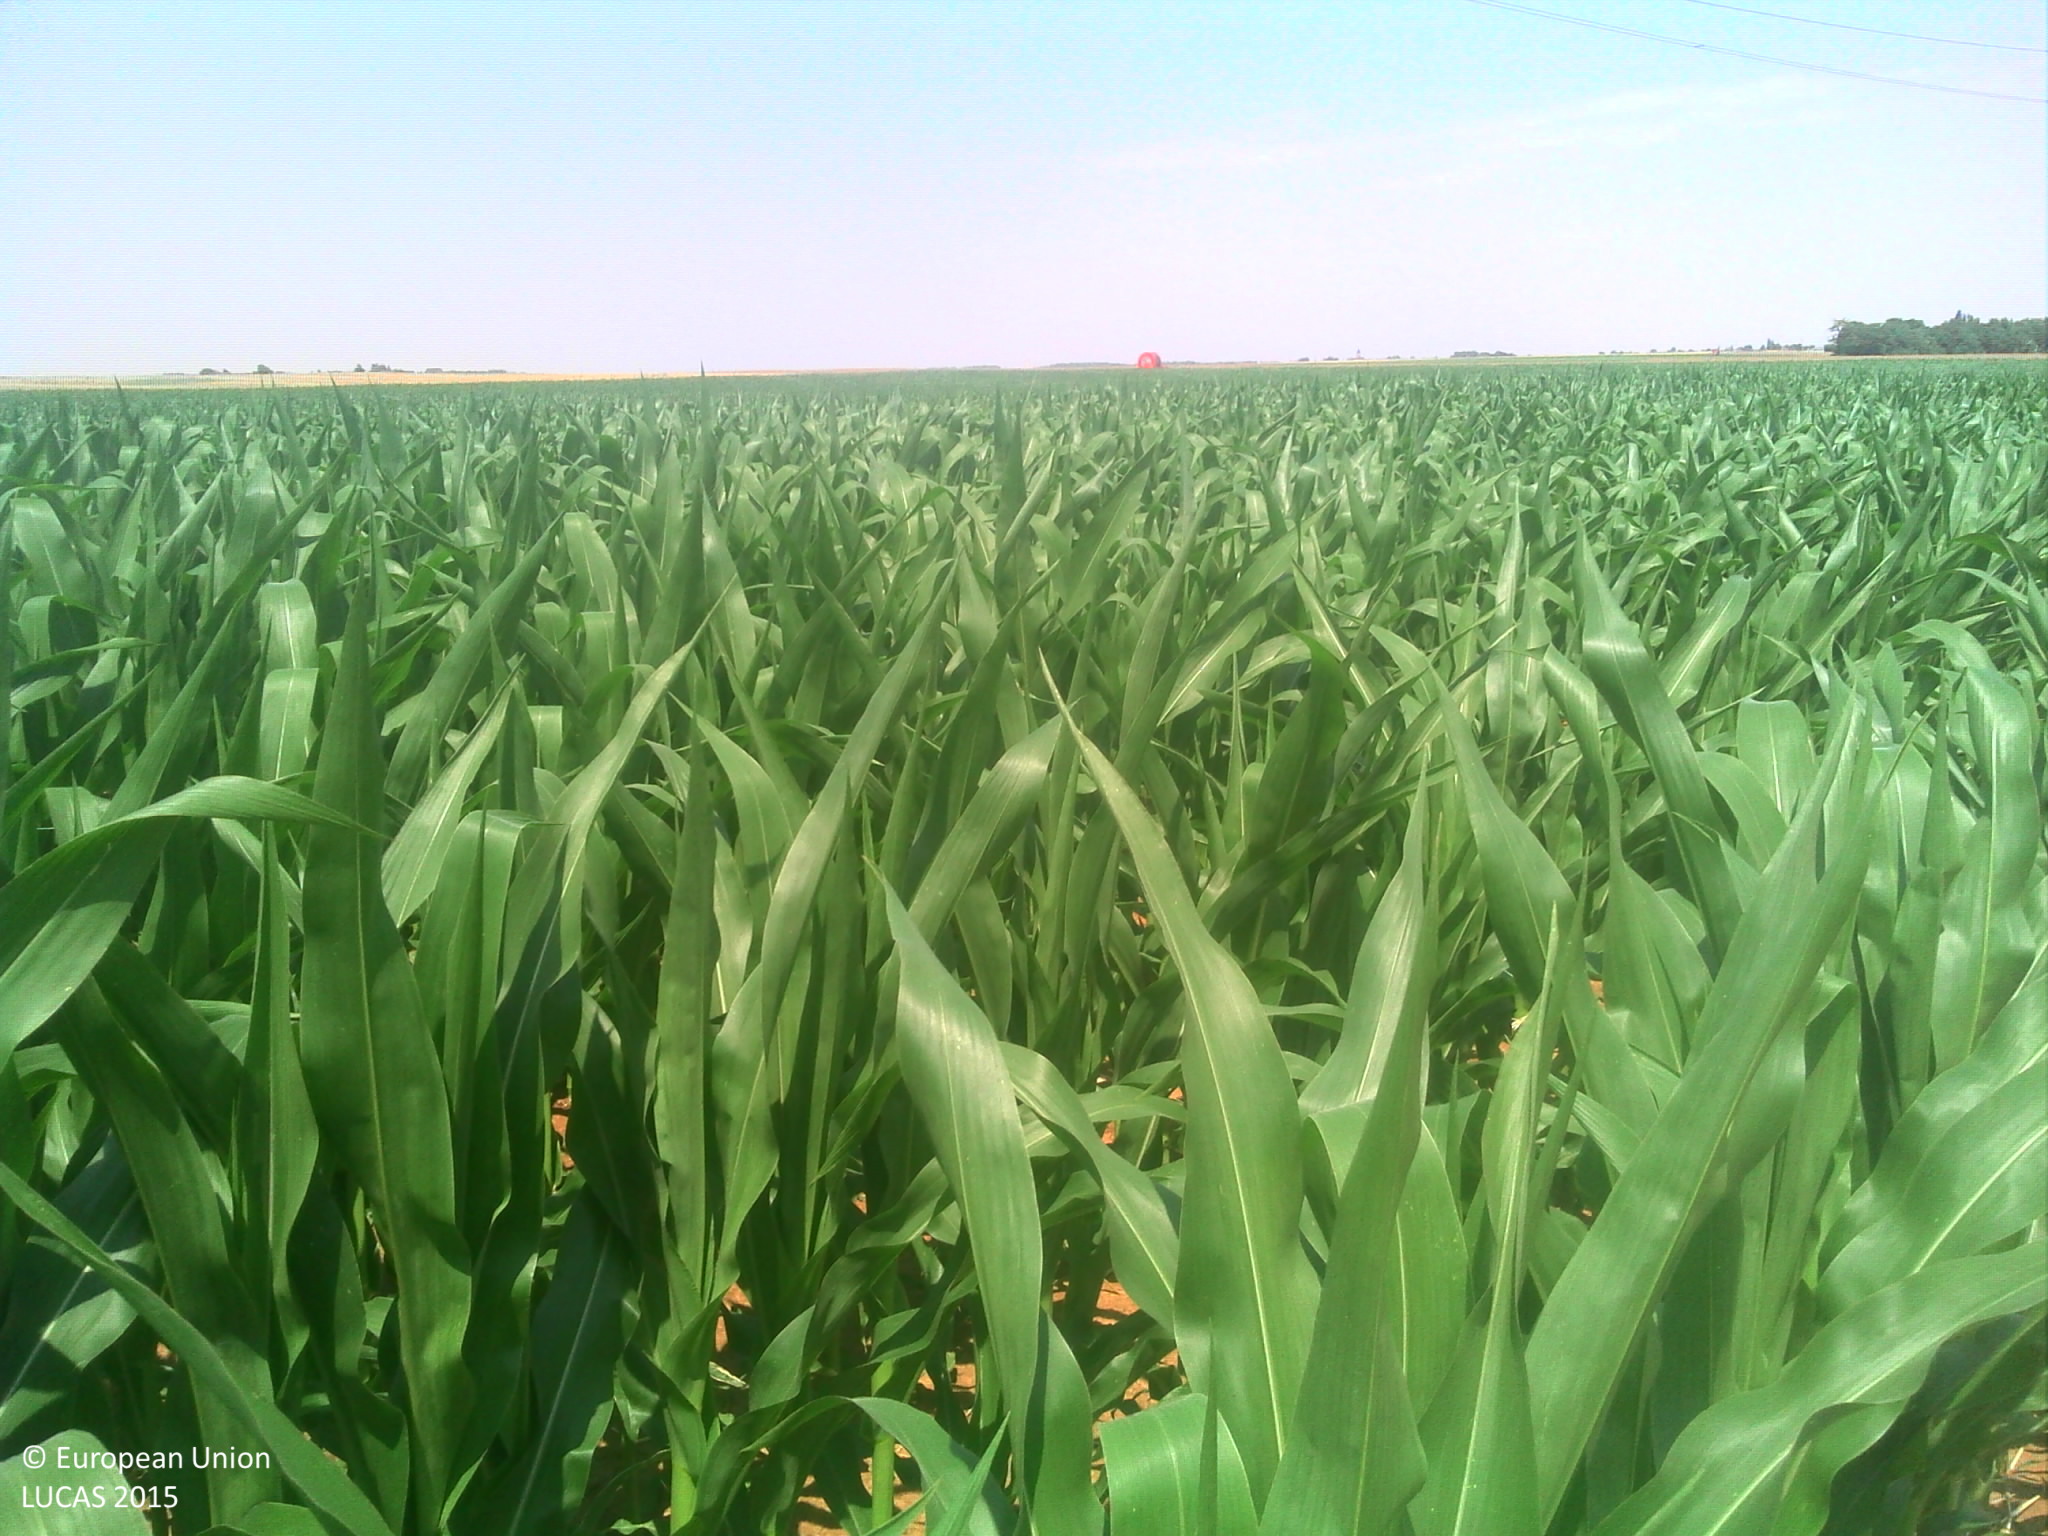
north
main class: Cropland
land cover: Maize
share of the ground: > 75 %
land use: Agriculture (excluding fallow land and kitchen gardens)
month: July
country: FR
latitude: 47.6673
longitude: 1.3683
